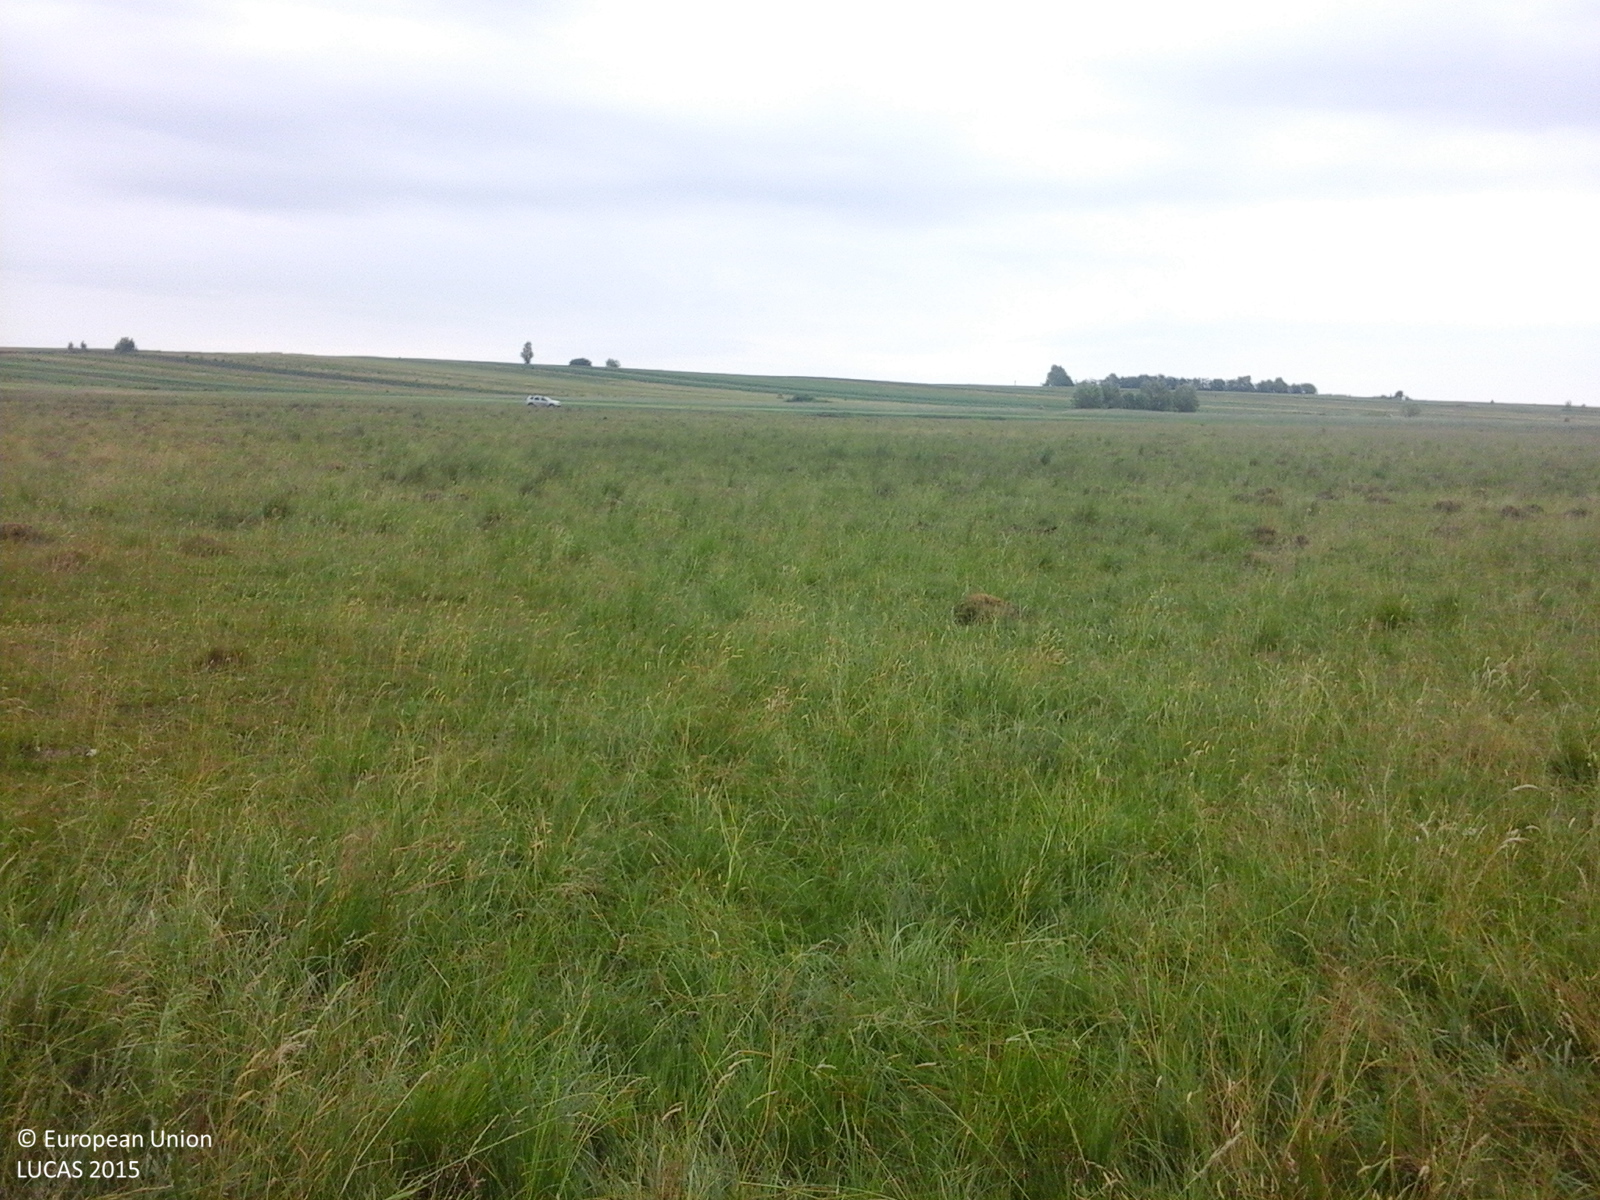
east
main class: Grassland
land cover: Grassland without tree/shrub cover
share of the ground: > 75 %
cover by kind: herbaceous plants 100 %
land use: Agriculture (excluding fallow land and kitchen gardens)
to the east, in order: Grassland without tree/shrub cover; Tracks; Grassland without tree/shrub cover; Ditches and canals; Grassland without tree/shrub cover; Tracks; Grassland without tree/shrub cover; Oats; Grassland without tree/shrub cover; Barley; Ditches and canals; Grassland without tree/shrub cover
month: June
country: RO
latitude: 47.4907
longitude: 26.2075
